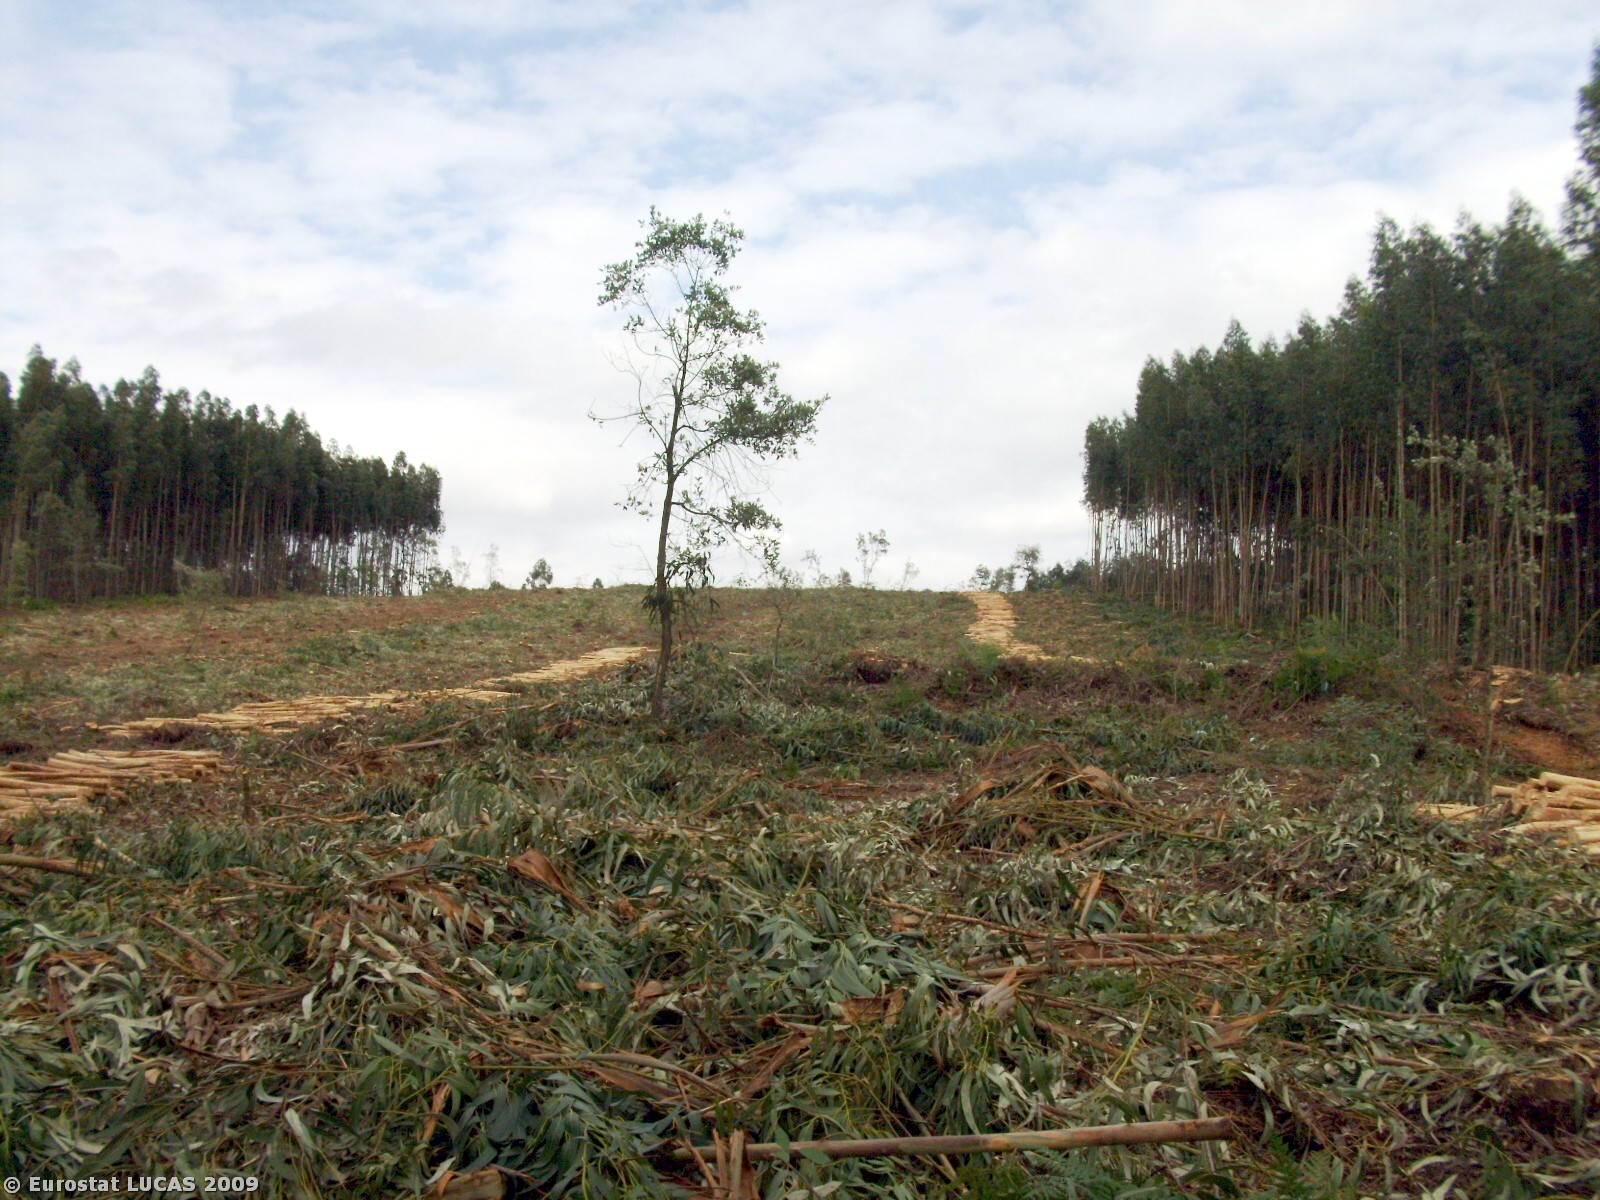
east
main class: Woodland
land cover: Broadleaved woodland
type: plantations and self-sown exotic forest
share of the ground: 10 - 25 %
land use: Forestry
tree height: > 5 m
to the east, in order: Broadleaved woodland; Electric lines; Broadleaved woodland
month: June
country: PT
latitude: 39.7257
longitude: -8.3306
